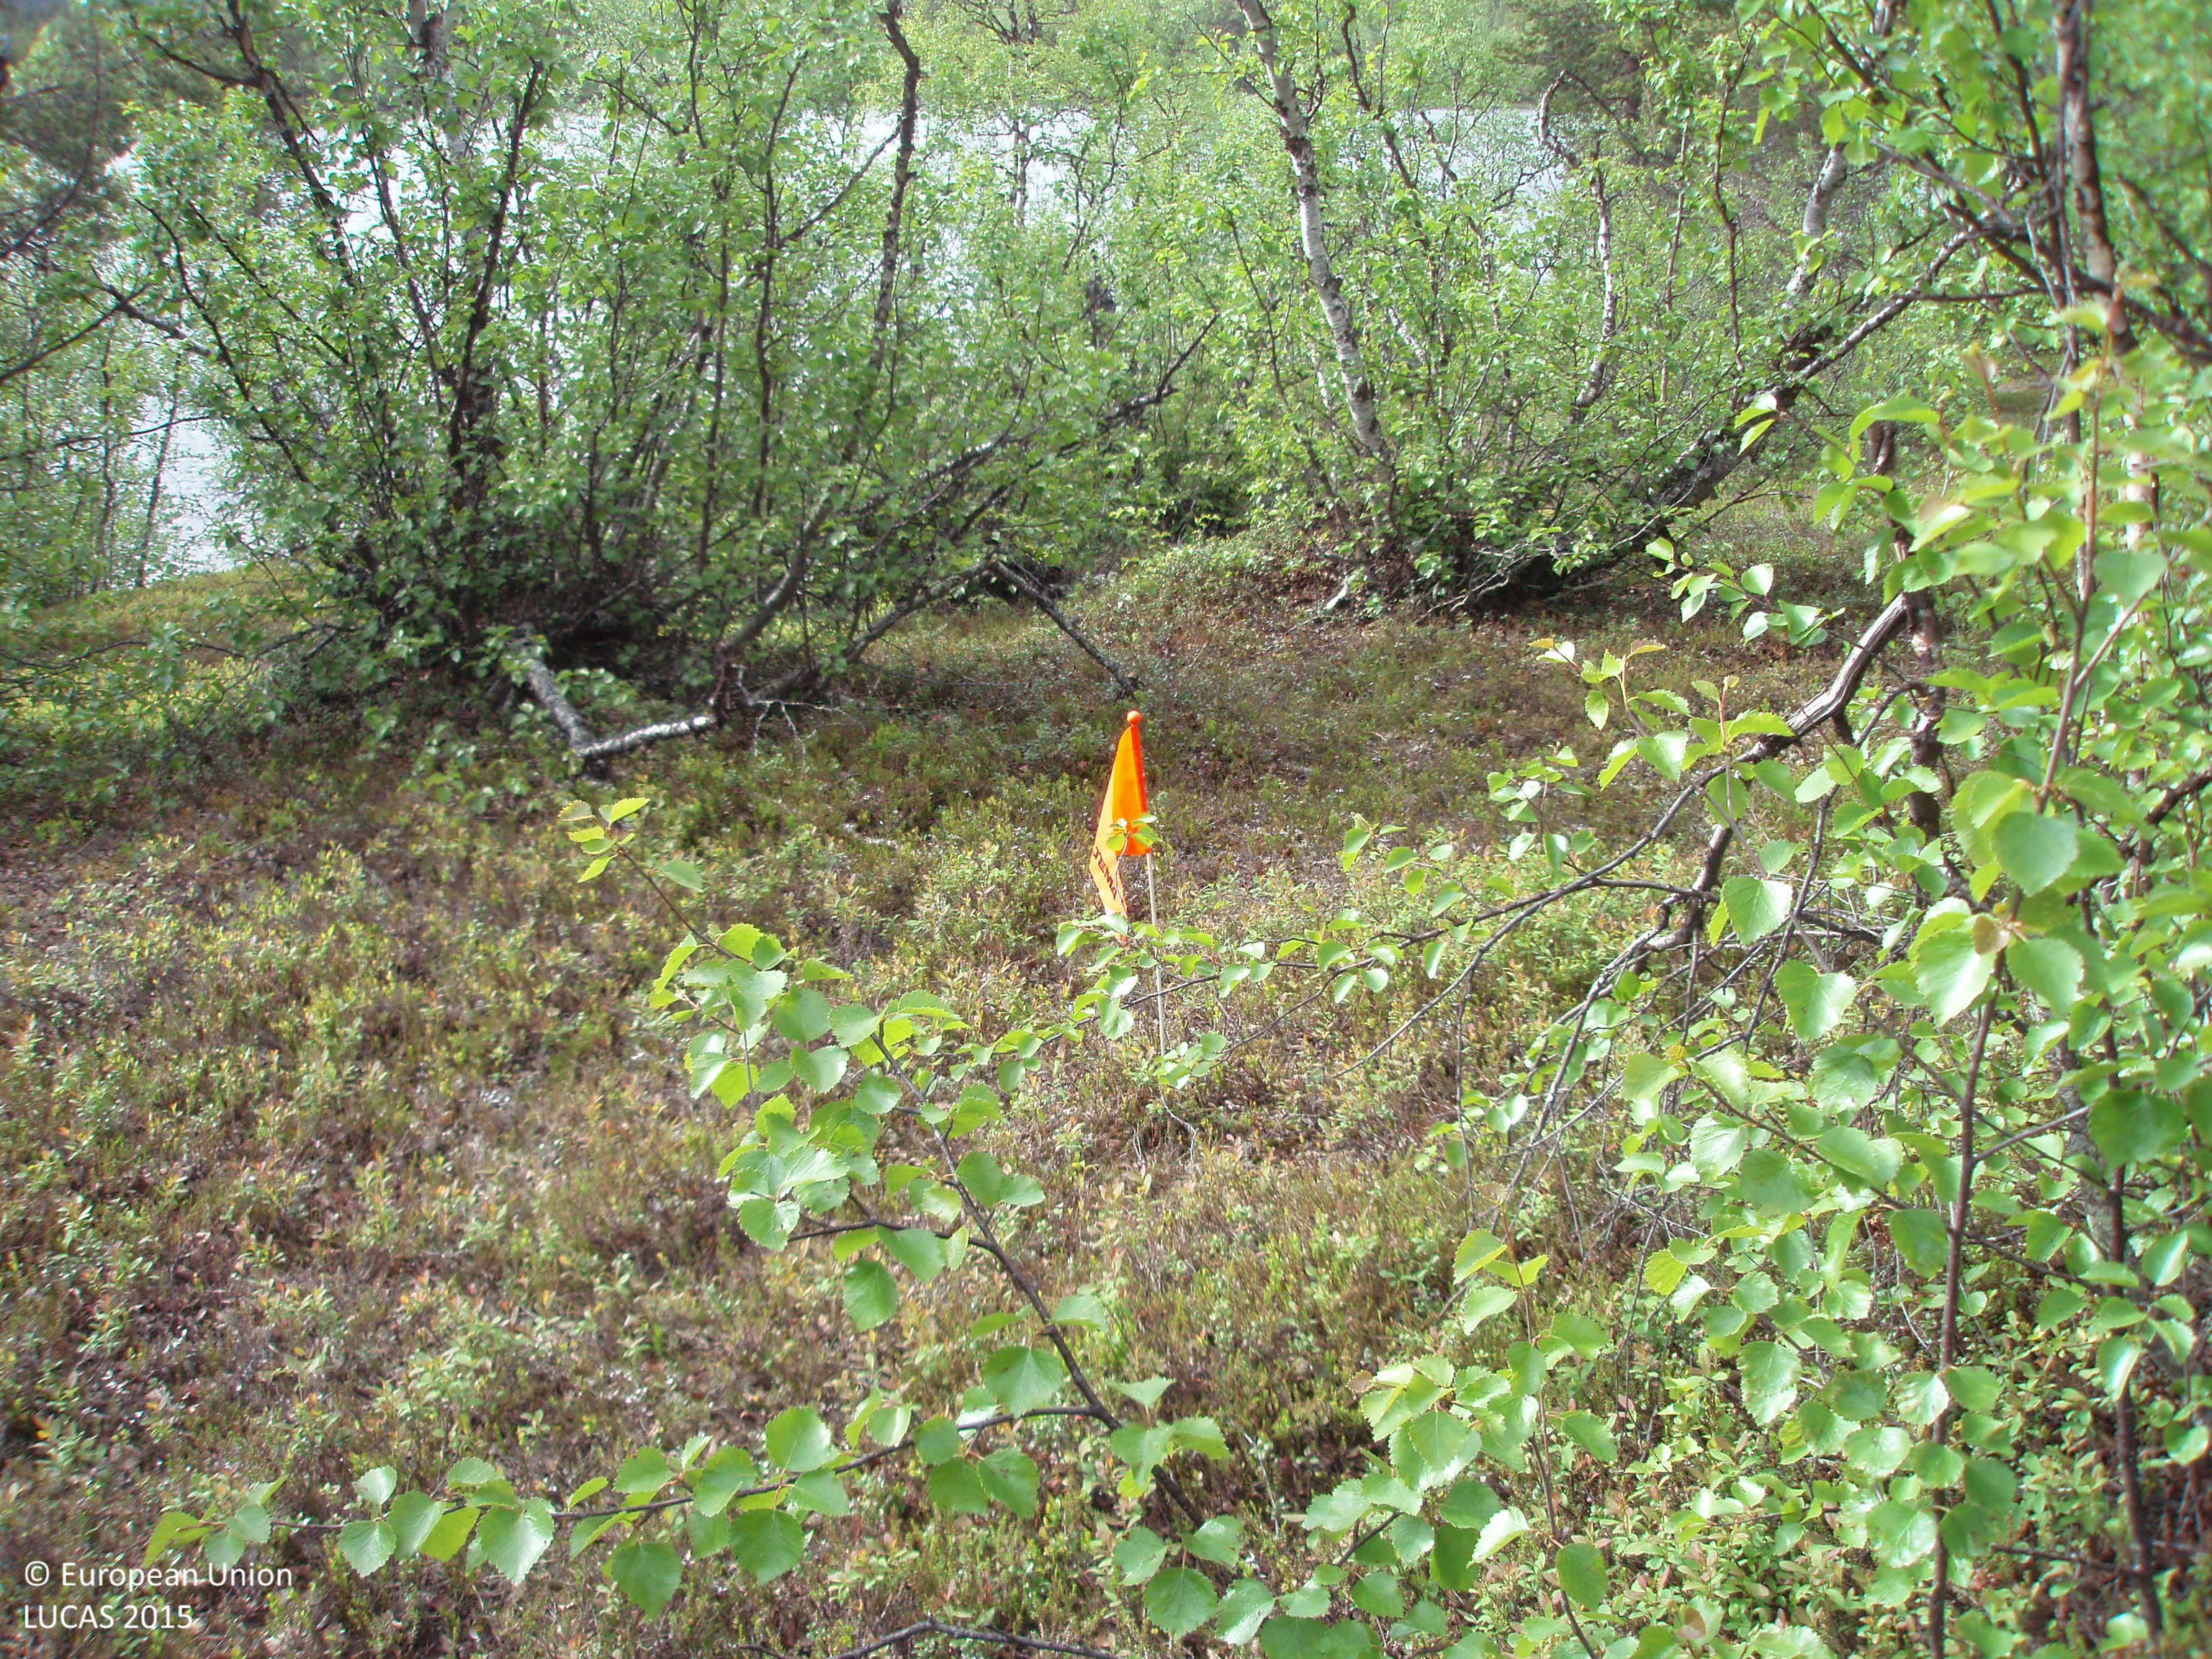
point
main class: Woodland
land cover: Broadleaved woodland
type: boreal forest
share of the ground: > 75 %
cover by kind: broadleaved forest trees 70 %, shrubs 20 %, coniferous forest trees 10 %
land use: Forestry
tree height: > 5 m
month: July
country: FI
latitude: 68.9693
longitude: 25.7353
